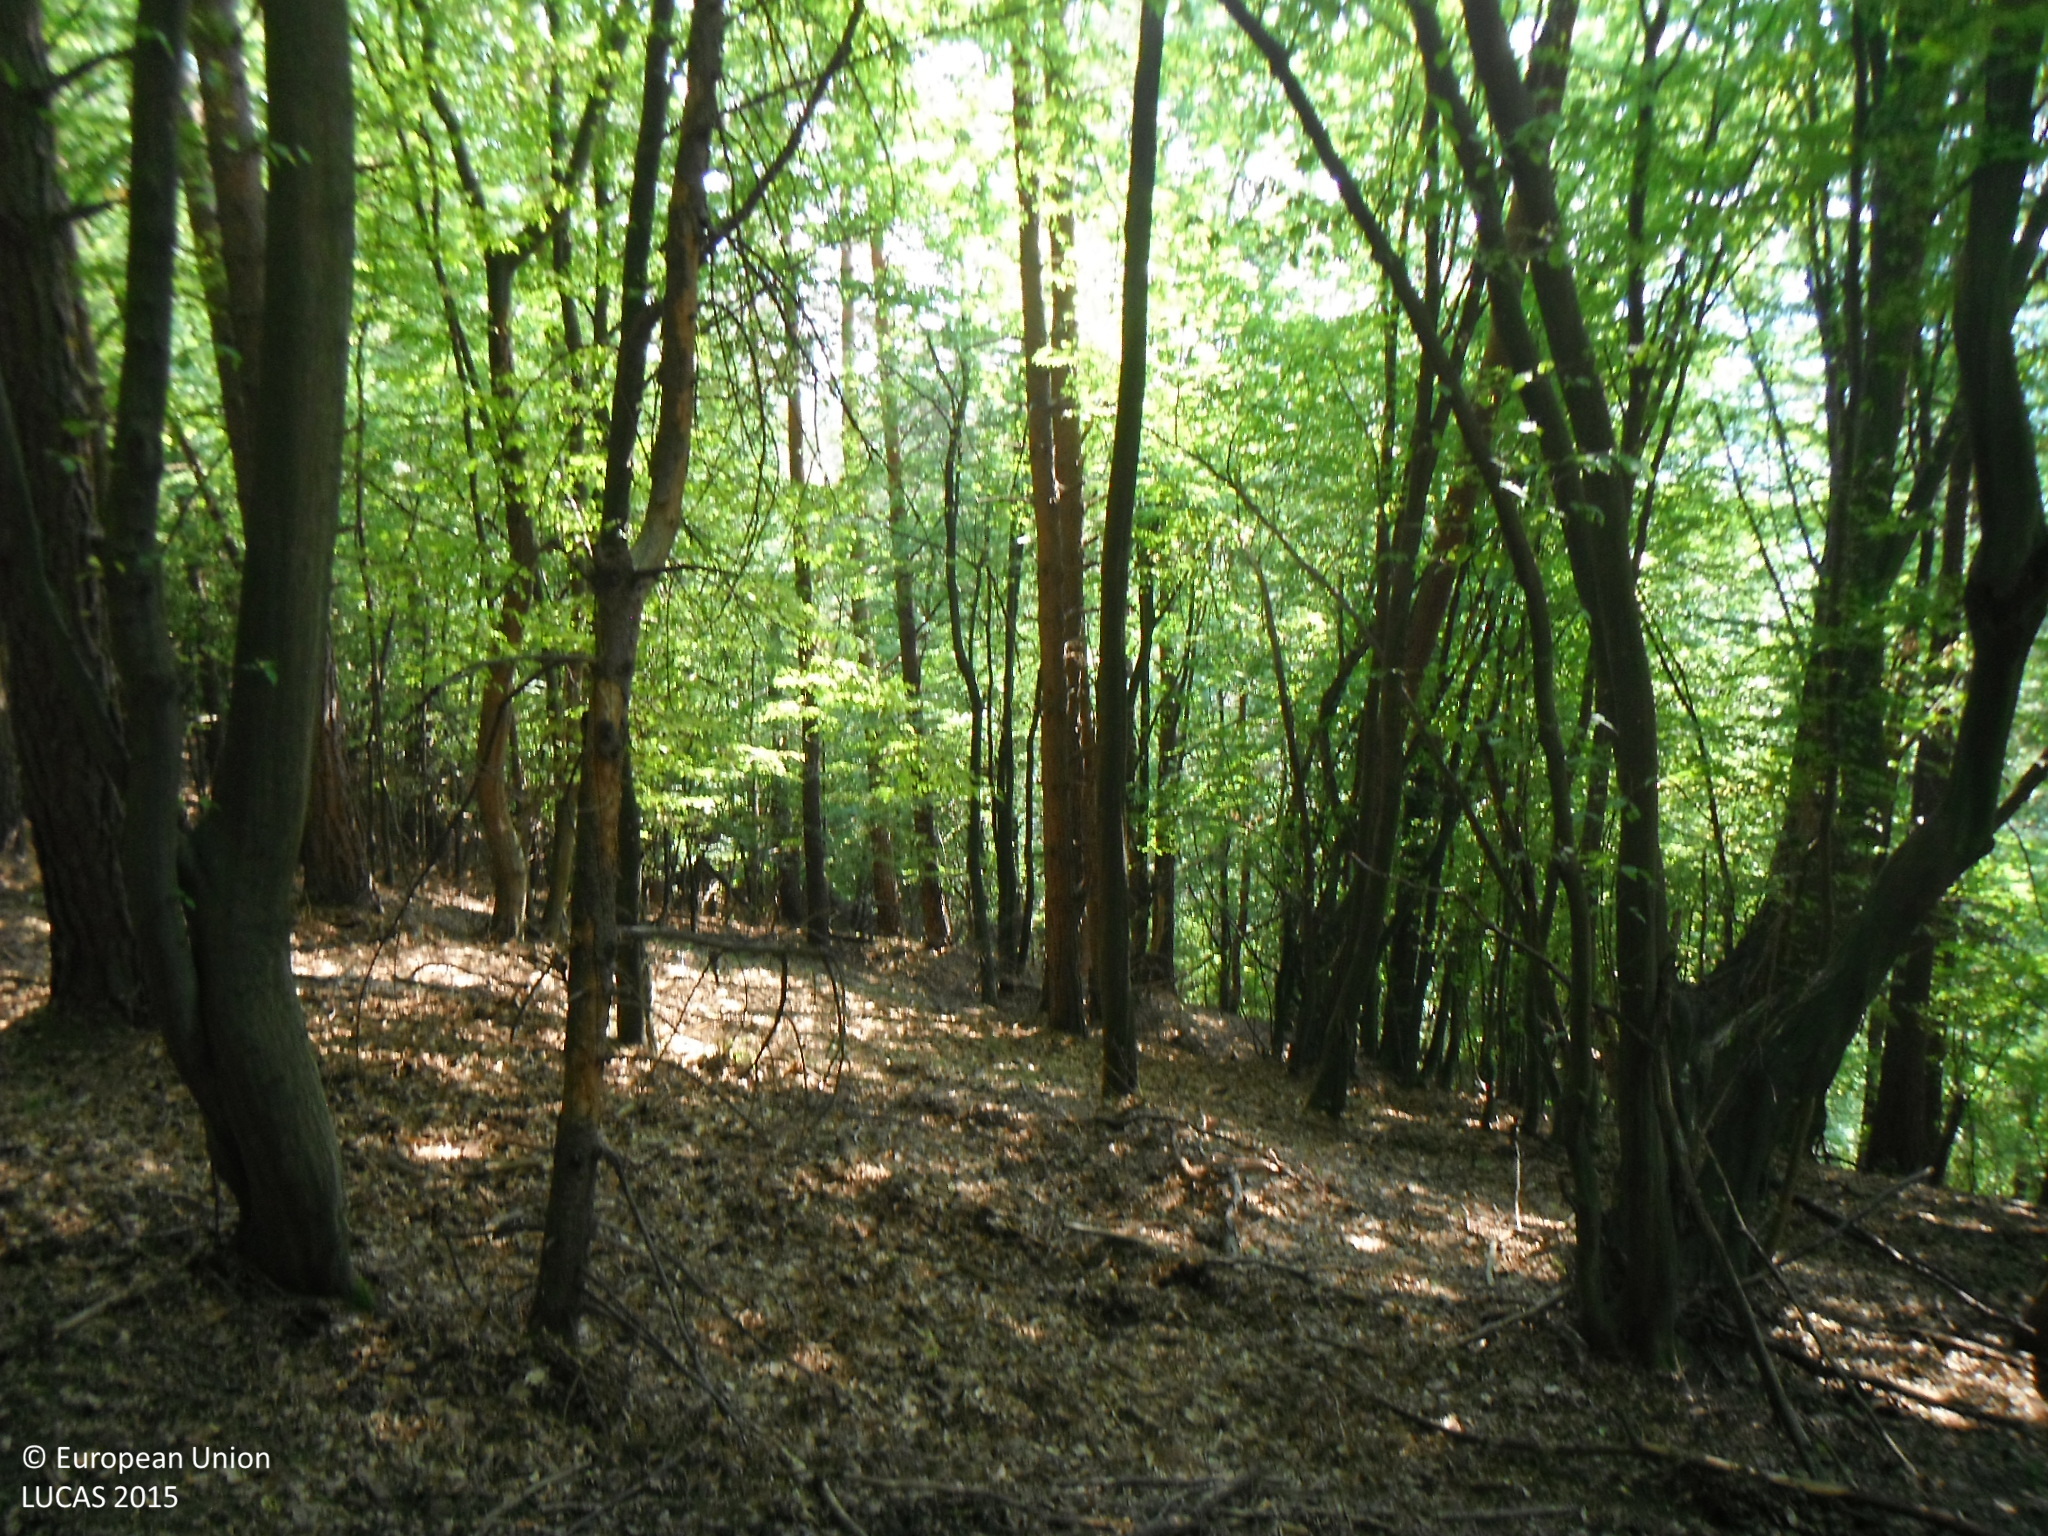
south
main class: Woodland
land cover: Pine dominated mixed woodland
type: mesophytic deciduous forest
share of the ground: > 75 %
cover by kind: broadleaved forest trees 60 %, coniferous forest trees 40 %
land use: Forestry
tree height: > 5 m
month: August
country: SK
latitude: 49.1770
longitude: 18.2883
